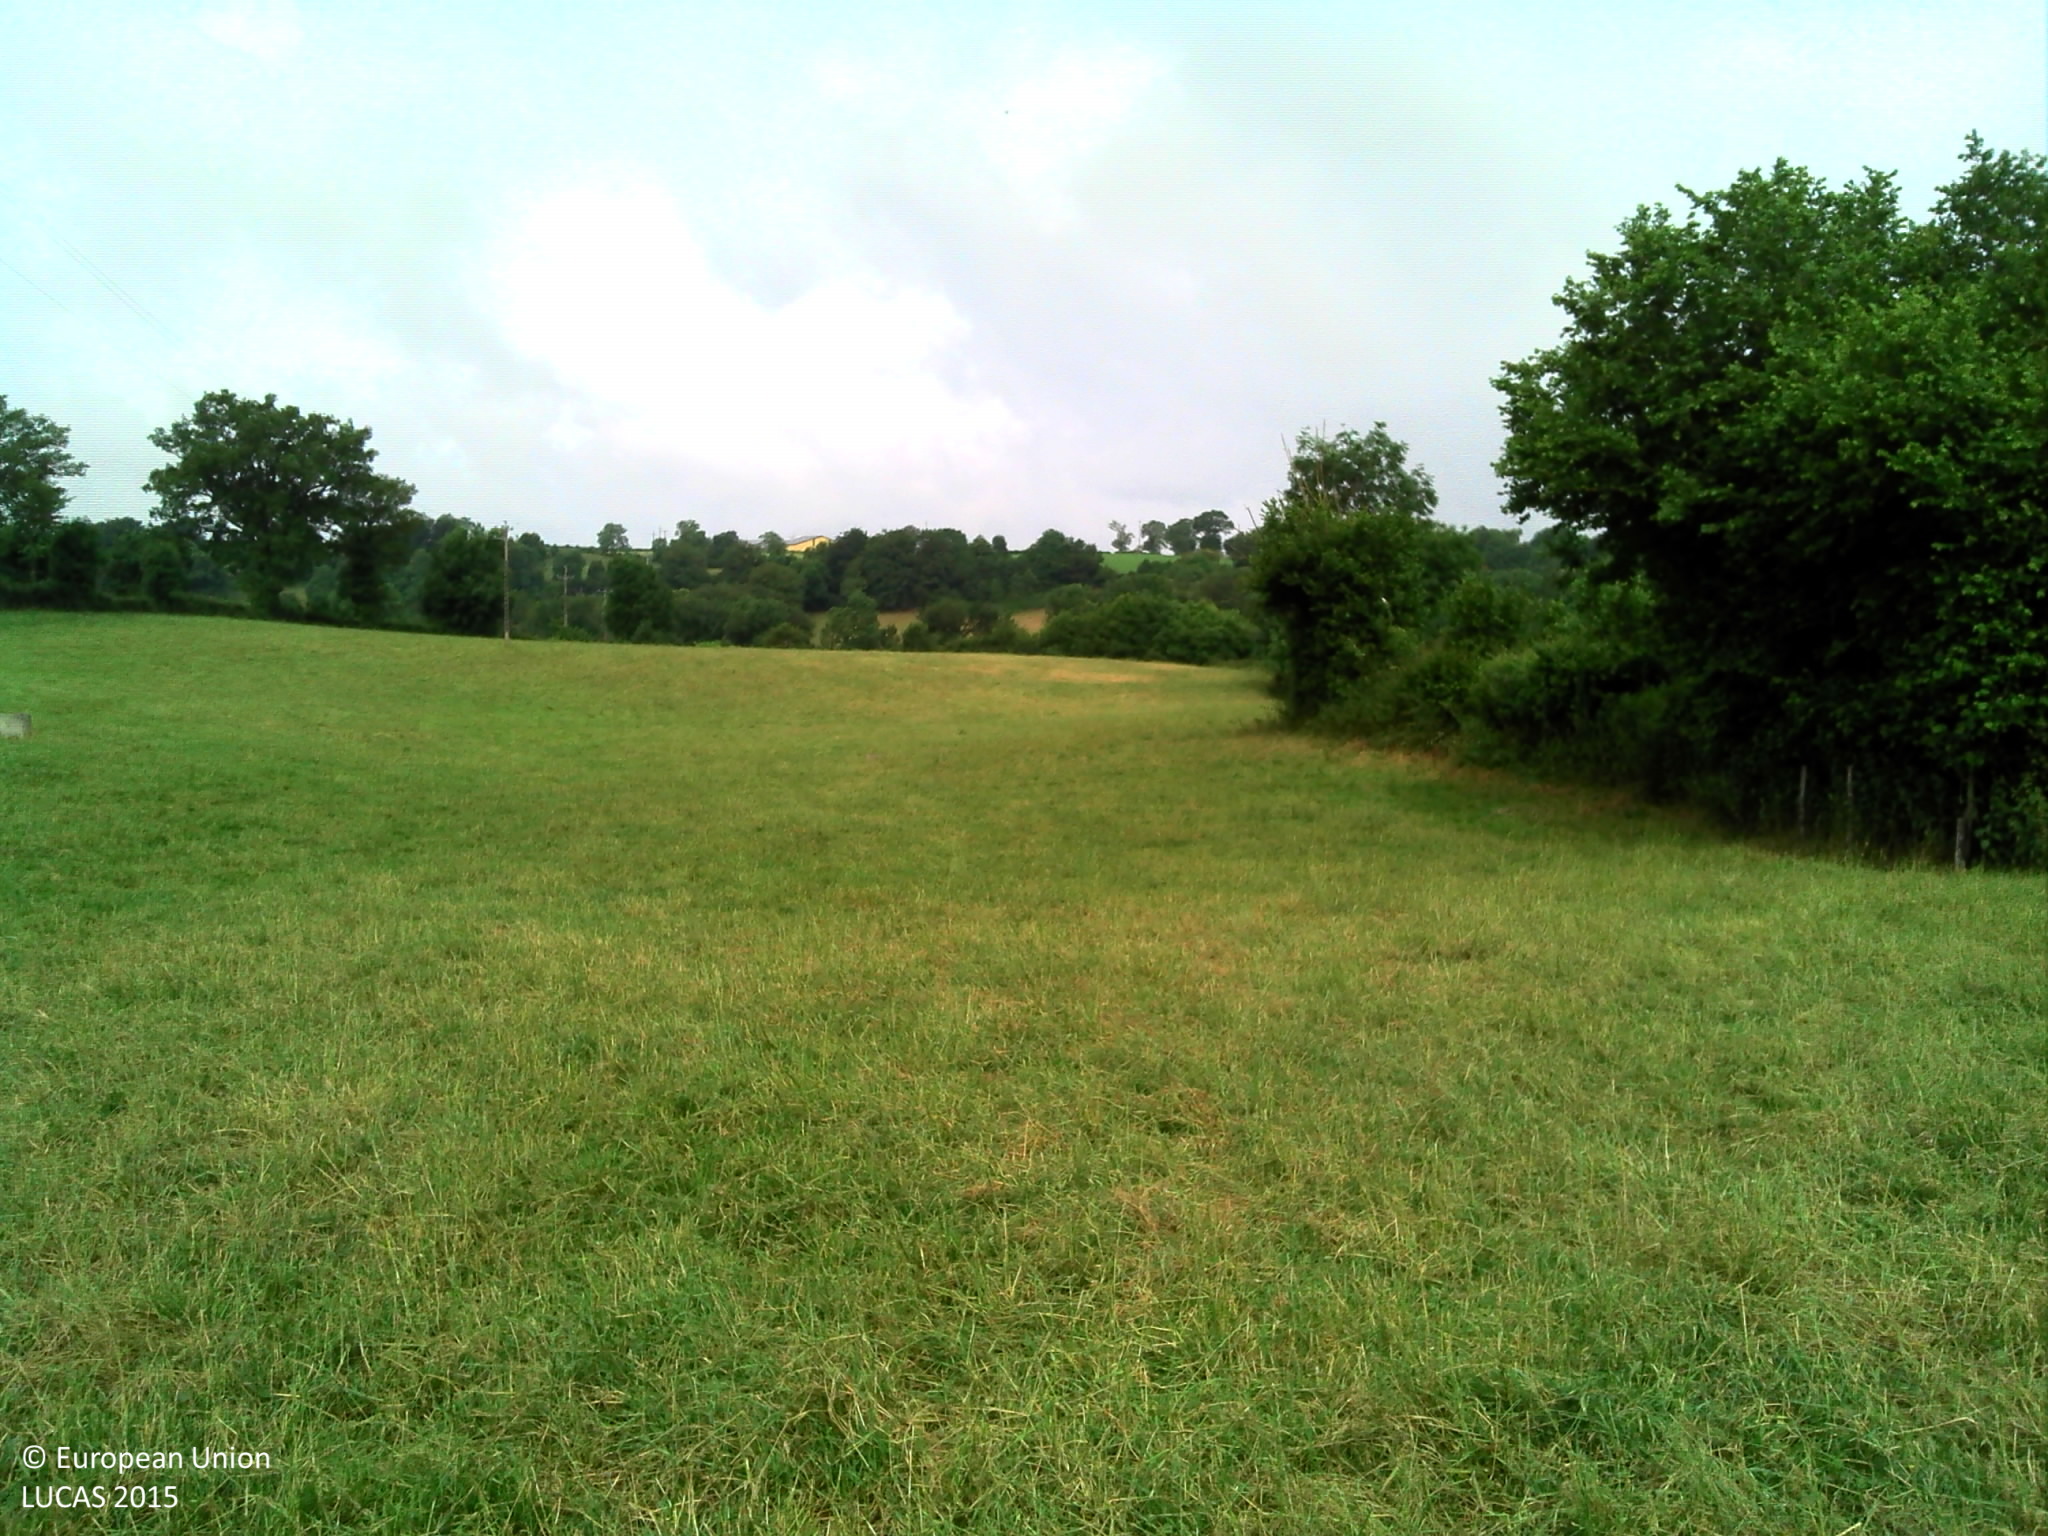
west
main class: Cropland
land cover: Temporary grasslands
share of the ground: > 75 %
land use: Agriculture (excluding fallow land and kitchen gardens)
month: June
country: FR
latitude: 44.2296
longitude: 2.5800
